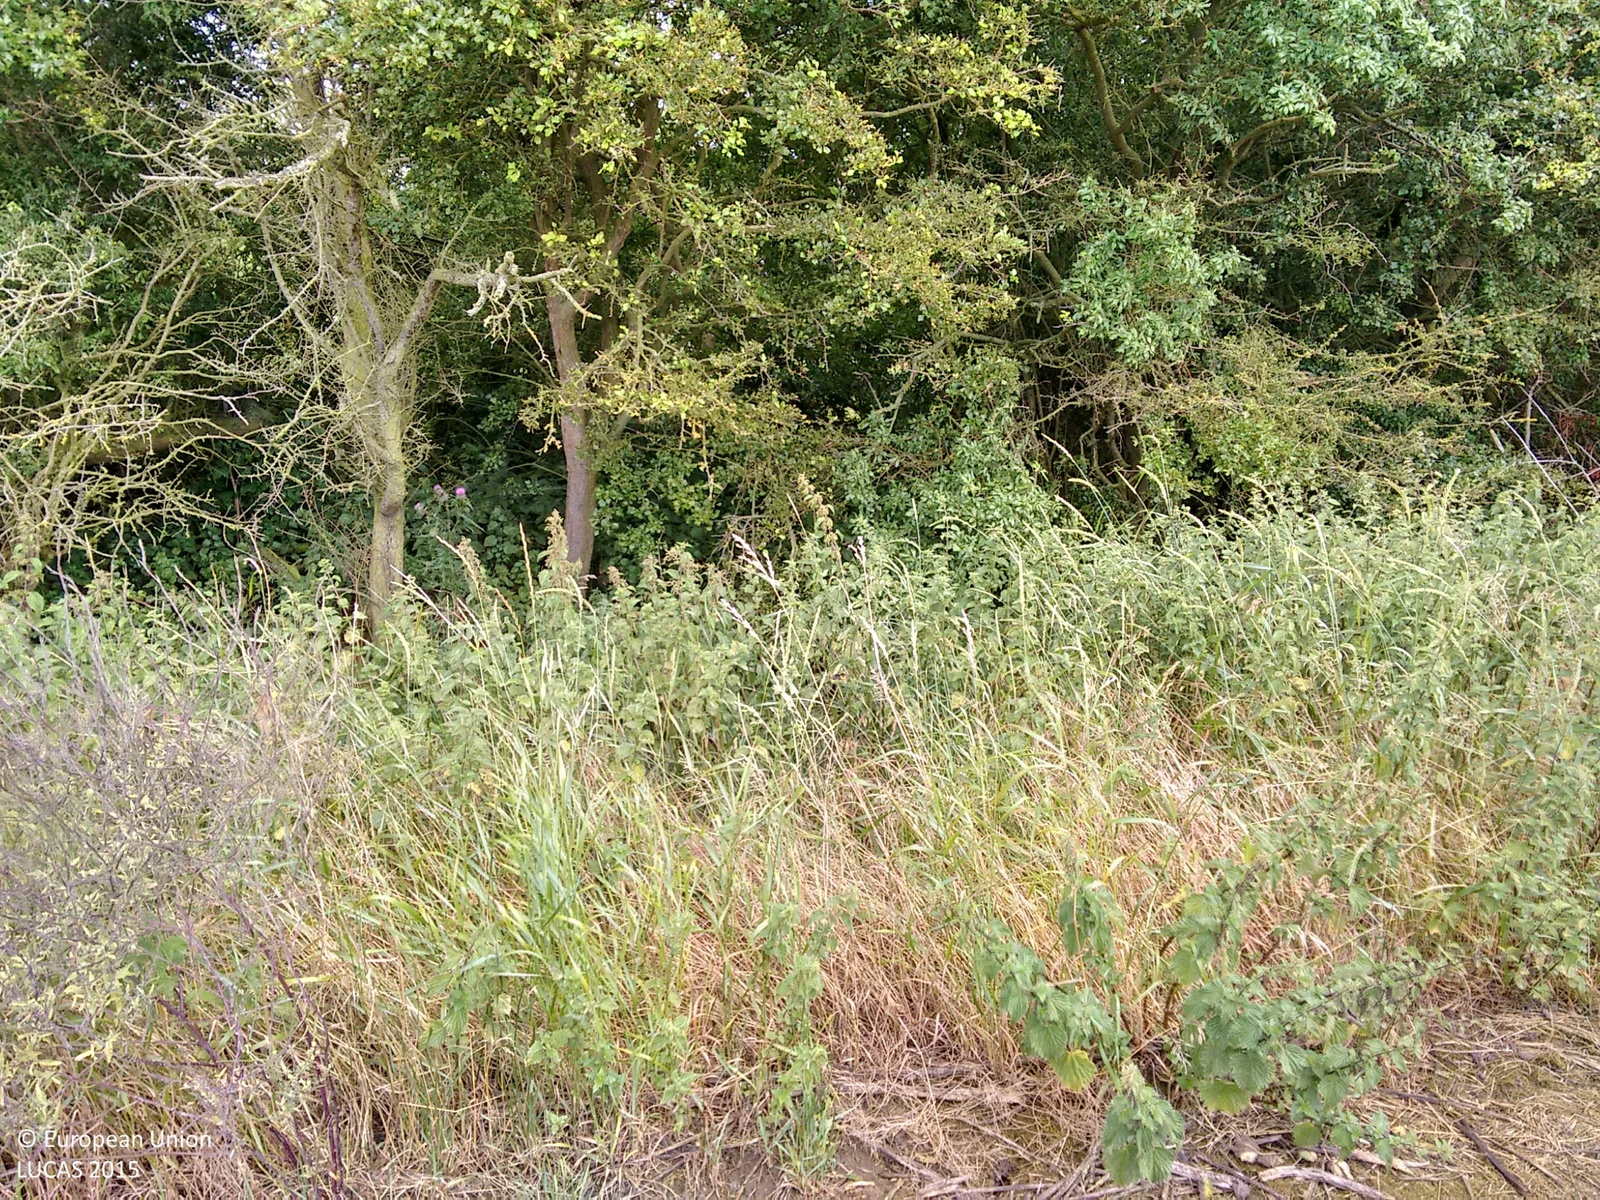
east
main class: Cropland
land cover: Common wheat
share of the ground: > 75 %
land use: Agriculture (excluding fallow land and kitchen gardens)
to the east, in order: Common wheat; Ditches and canals; Broadleaved woodland; Ditches and canals; Grass margins; Tracks; Grass margins; Ditches and canals; Single bushes/trees; Common wheat
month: July
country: GB
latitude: 52.7733
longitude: -0.7880
